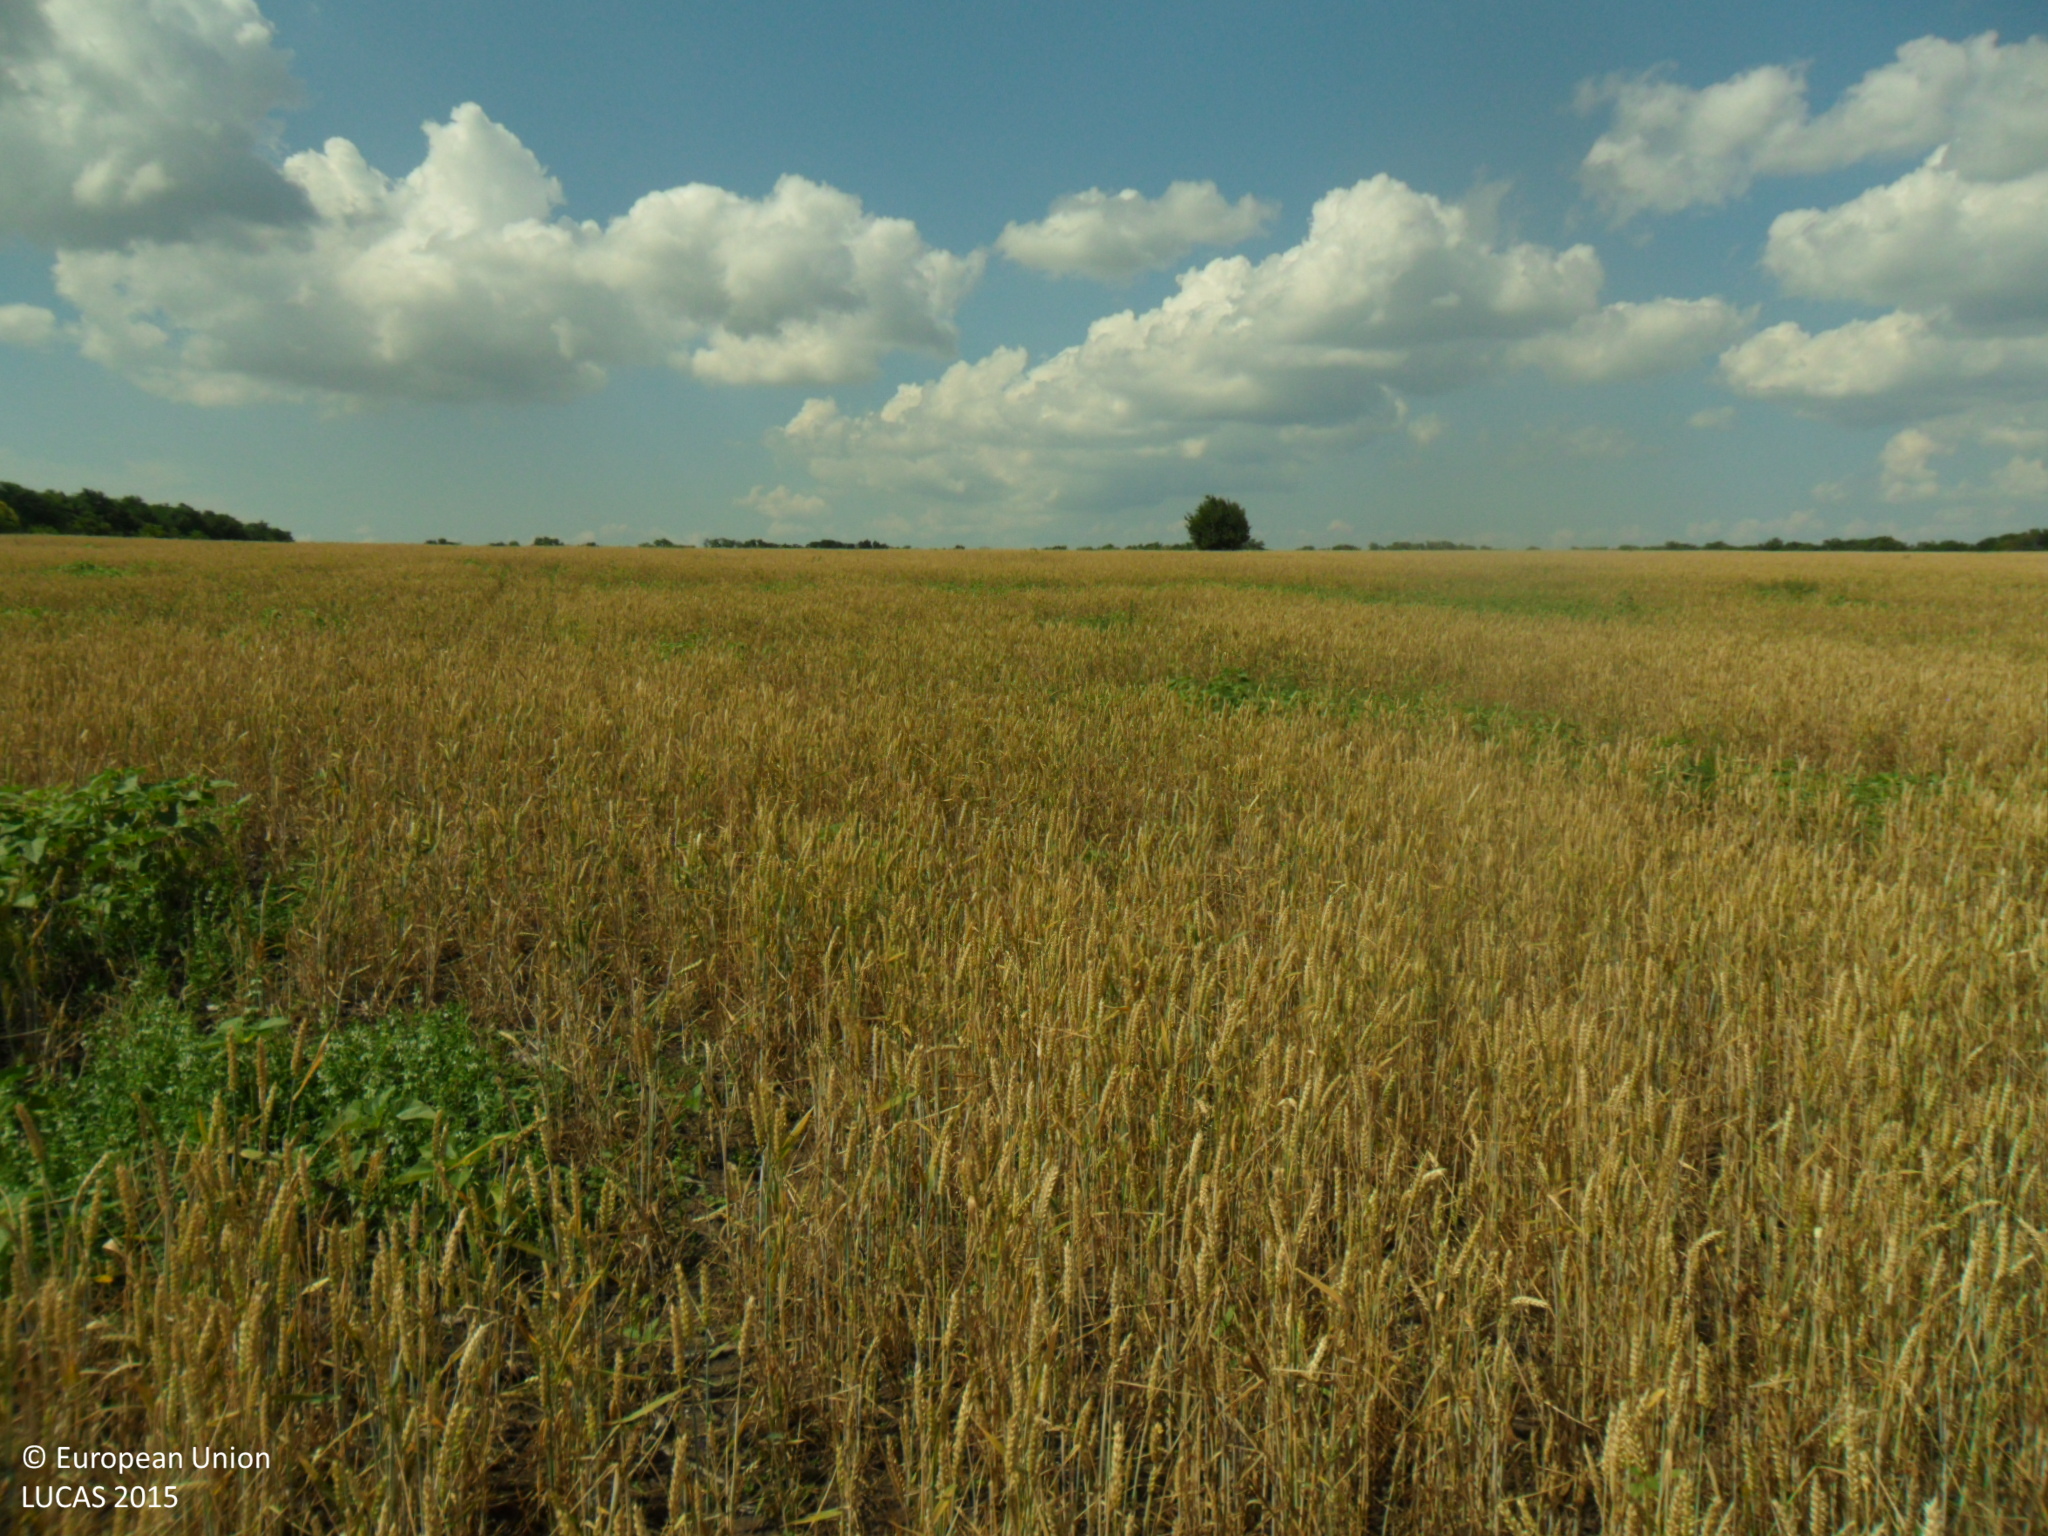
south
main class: Cropland
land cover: Common wheat
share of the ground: > 75 %
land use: Agriculture (excluding fallow land and kitchen gardens)
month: June
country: BG
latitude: 43.3573
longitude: 27.0072
